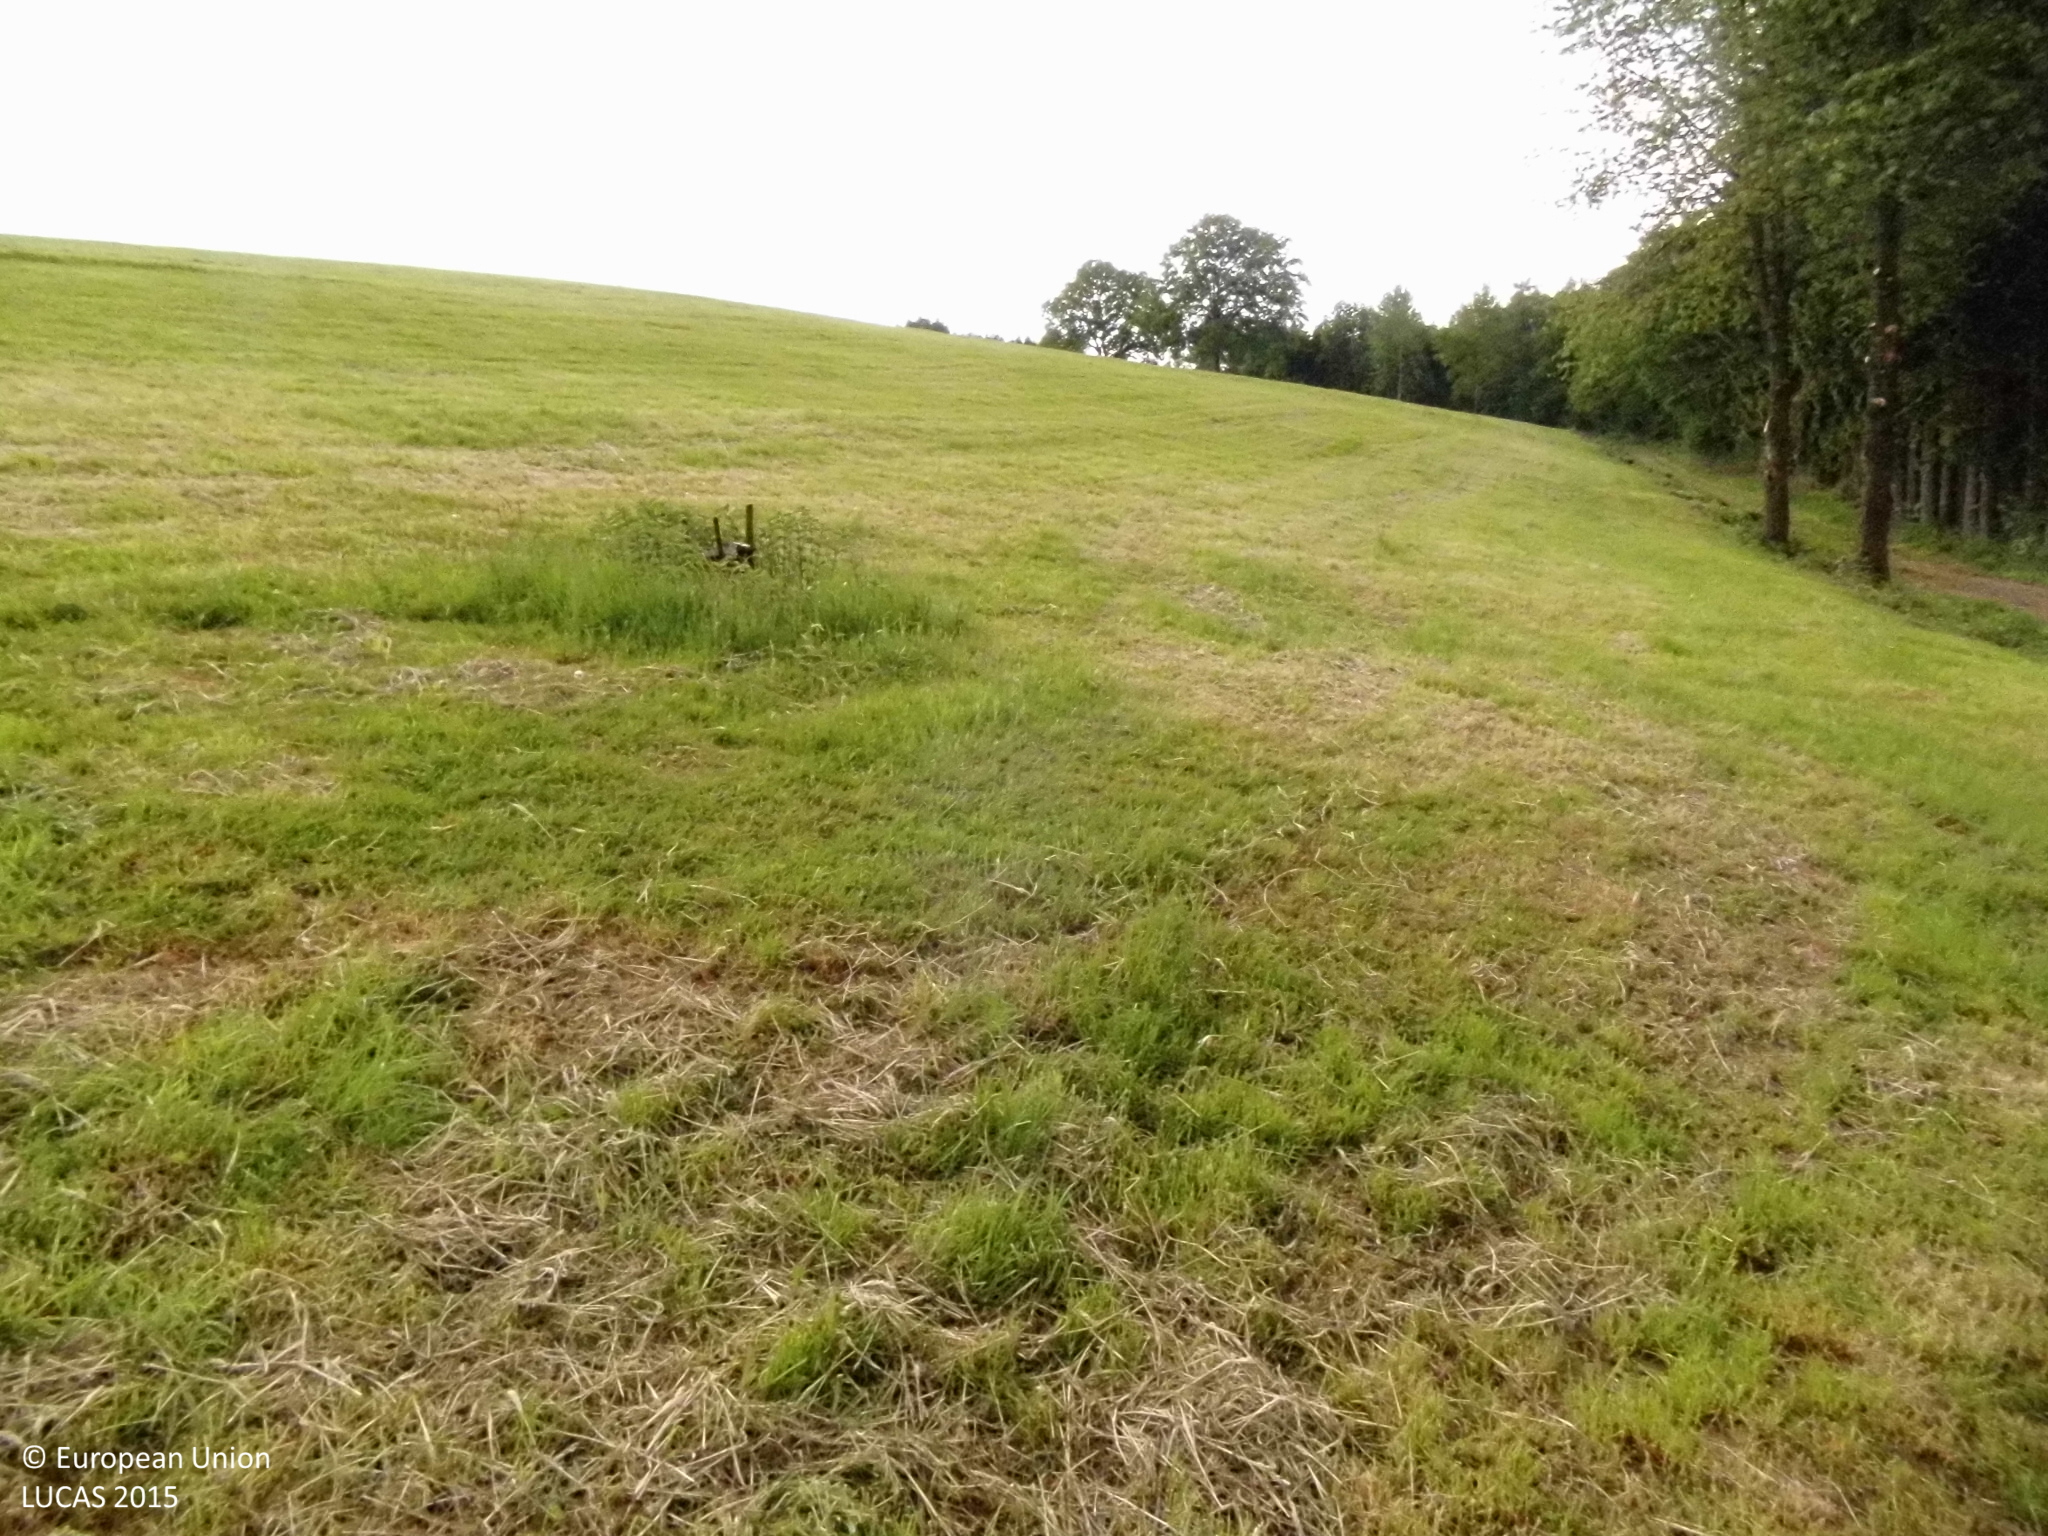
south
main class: Grassland
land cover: Grassland with sparse tree/shrub cover
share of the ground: > 75 %
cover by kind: herbaceous plants 90 %, broadleaved forest trees 5 %, unconsolidated bare surface 5 %
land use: Agriculture (excluding fallow land and kitchen gardens)
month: May
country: DE
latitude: 50.8934
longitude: 7.4554
